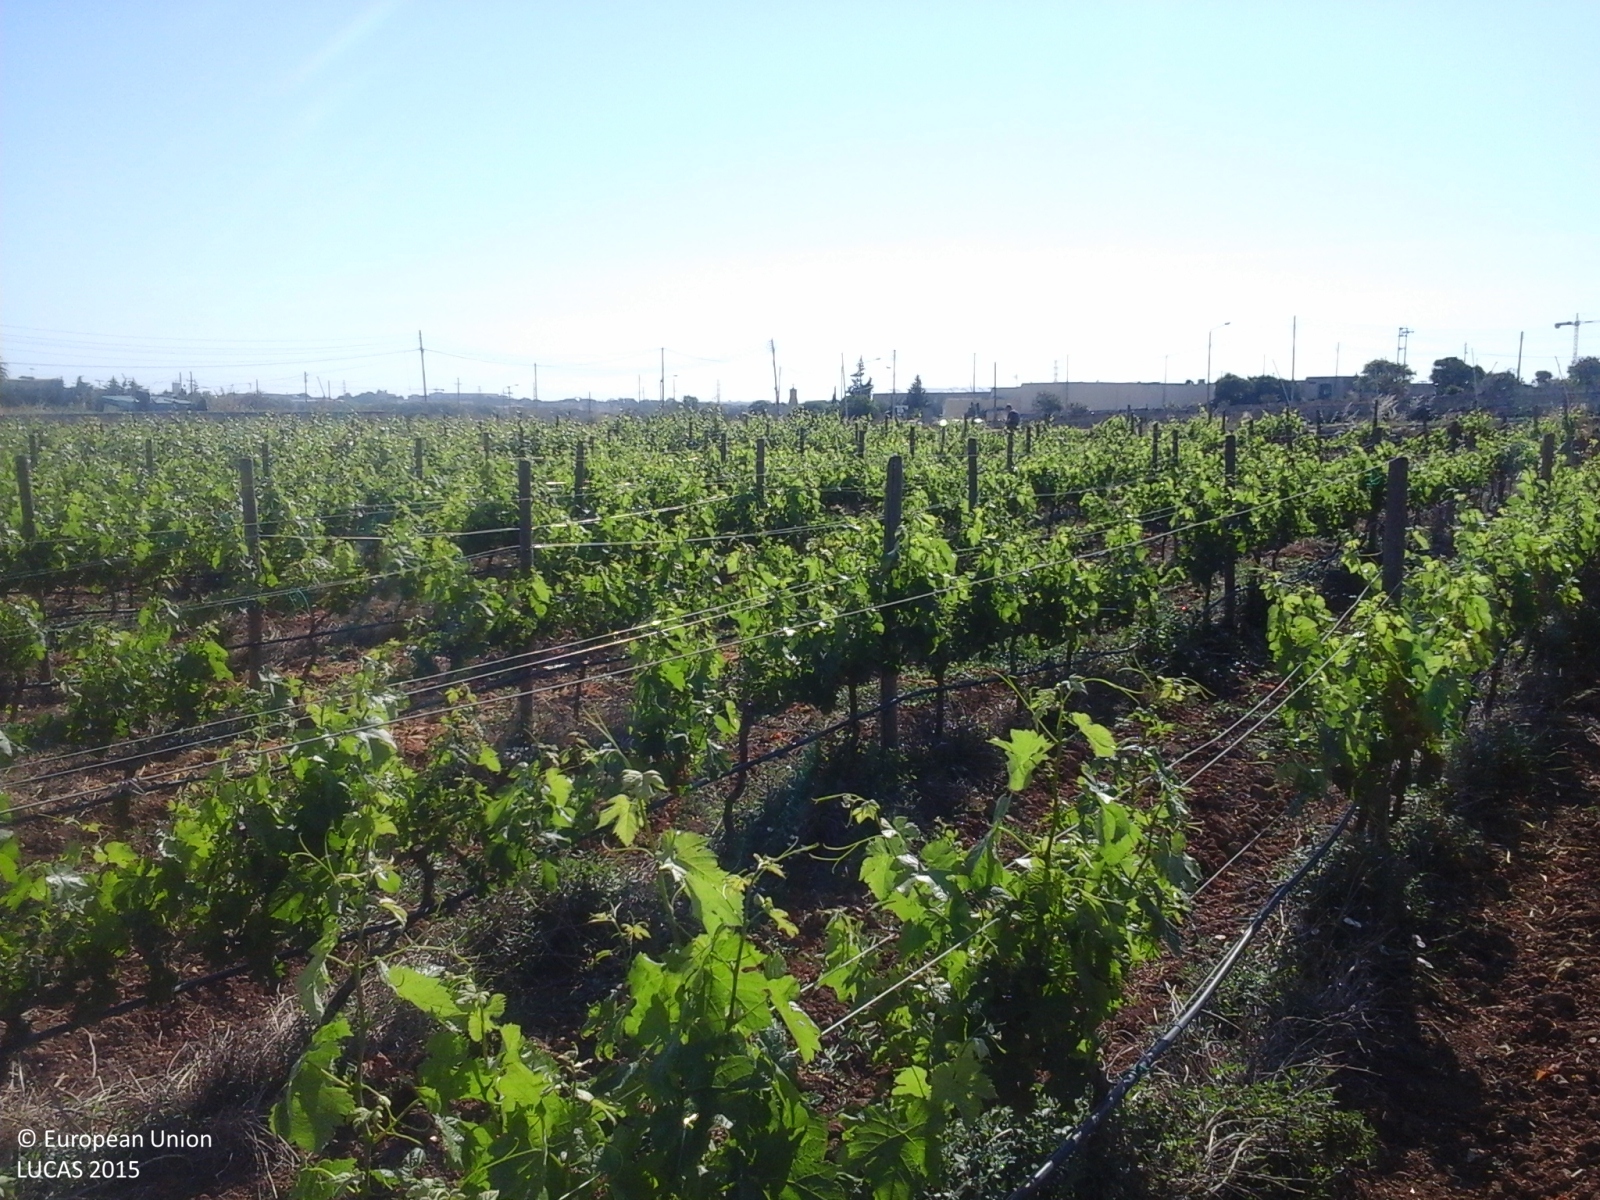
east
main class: Cropland
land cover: Vineyards
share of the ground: 25 - 50 %
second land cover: Other bare soil
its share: > 75 %
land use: Agriculture (excluding fallow land and kitchen gardens)
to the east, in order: Vineyards; Other bare soil; Dry stone walls; Potatoes; Dry stone walls; Mixed cereals for fodder; Dry stone walls; Electric lines; Paved roads, cycling and walking lanes; Dry stone walls; Other fresh vegetables; Potatoes; Dry pulses; Dry stone walls; Artificial constructions in urban areas
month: May
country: MT
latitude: 35.8571
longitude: 14.5094
